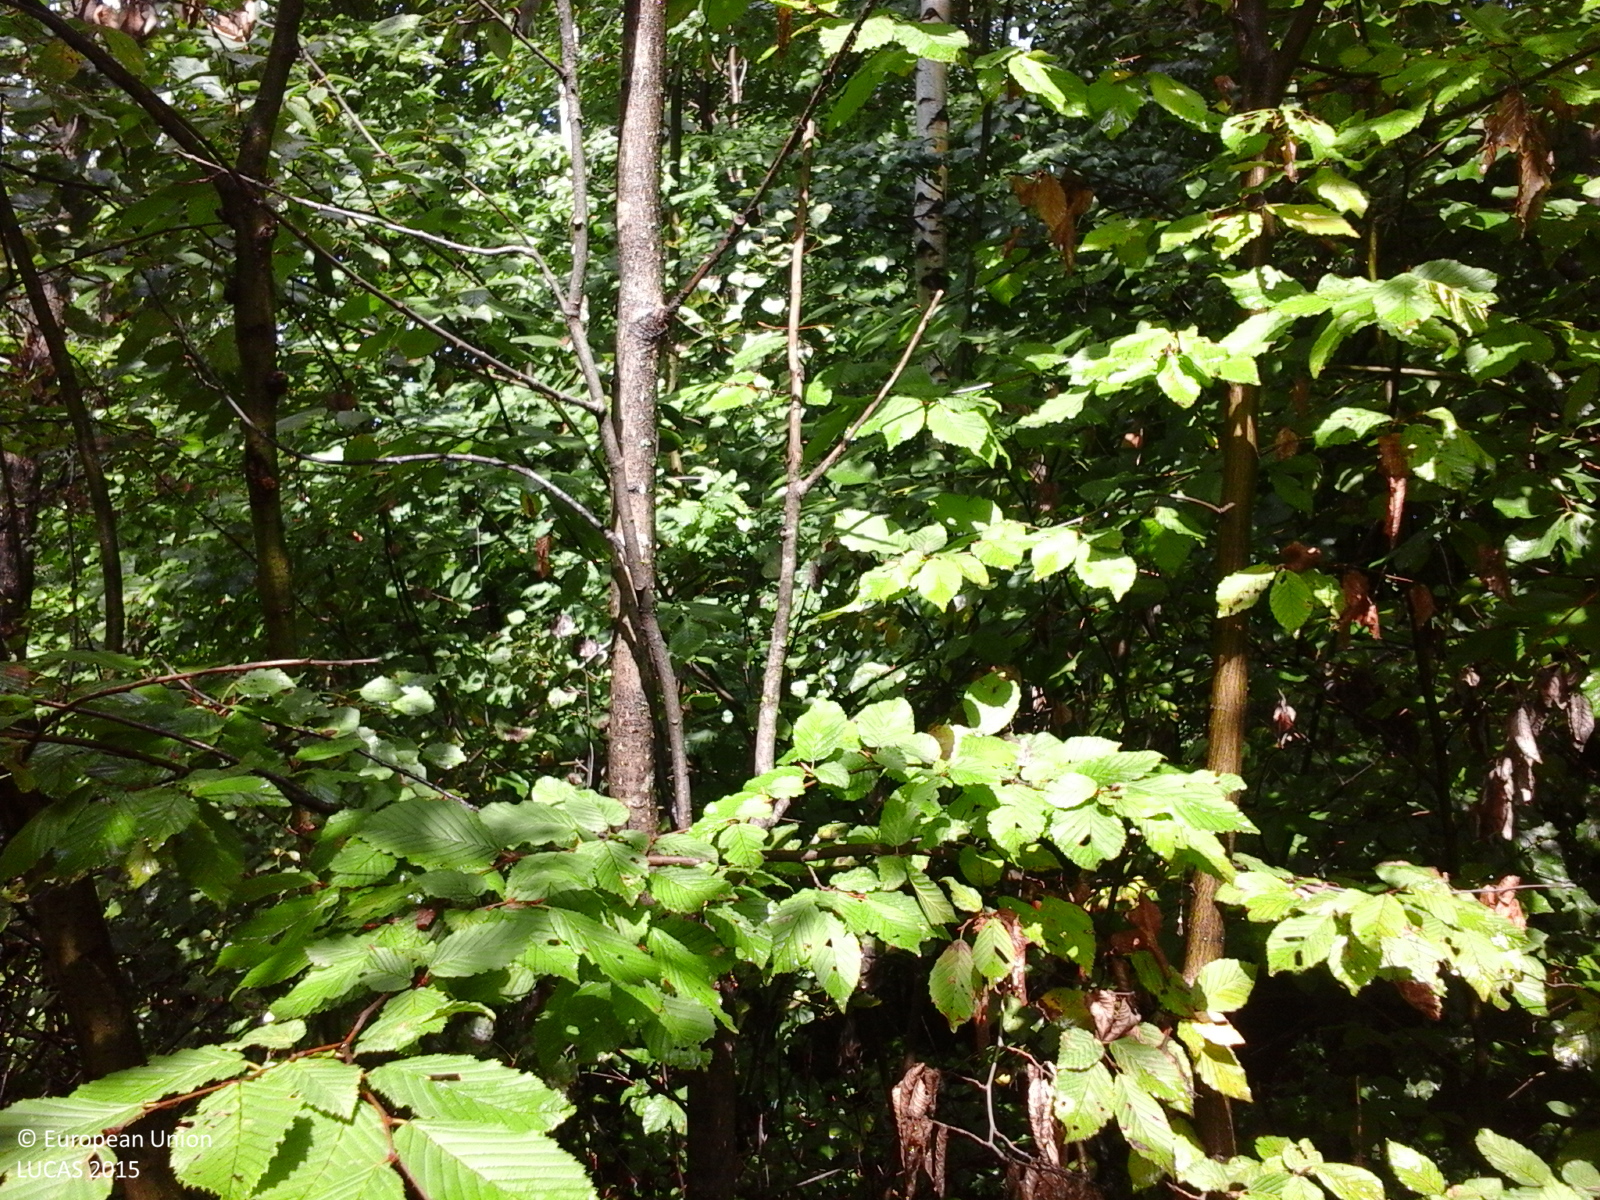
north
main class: Woodland
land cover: Broadleaved woodland
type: acidophilous oak and oak-birch forest
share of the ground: > 75 %
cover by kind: broadleaved forest trees 100 %
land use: Forestry
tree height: > 5 m
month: September
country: RO
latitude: 45.2241
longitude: 24.5328
